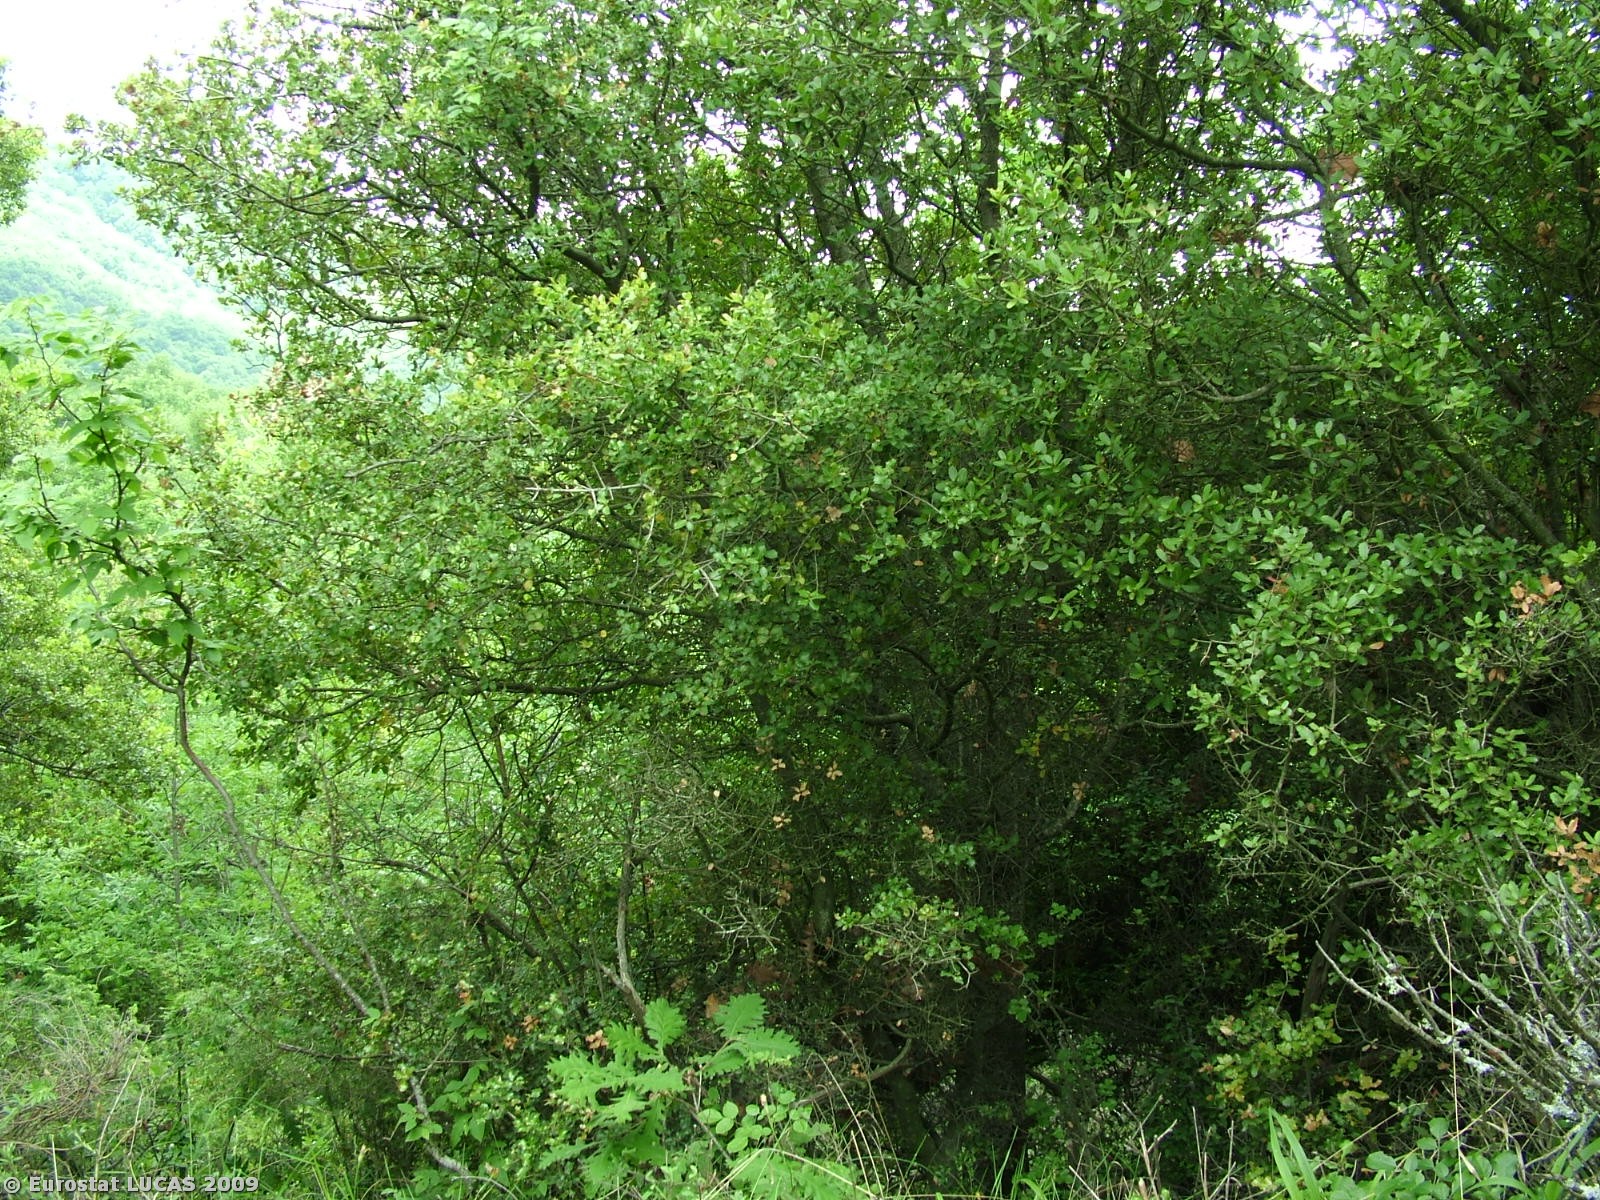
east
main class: Woodland
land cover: Broadleaved woodland
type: thermophilous deciduous forest
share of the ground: > 75 %
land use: Agriculture (excluding fallow land and kitchen gardens)
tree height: > 5 m
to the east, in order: Broadleaved woodland
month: May
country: GR
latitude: 41.1129
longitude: 24.6007
